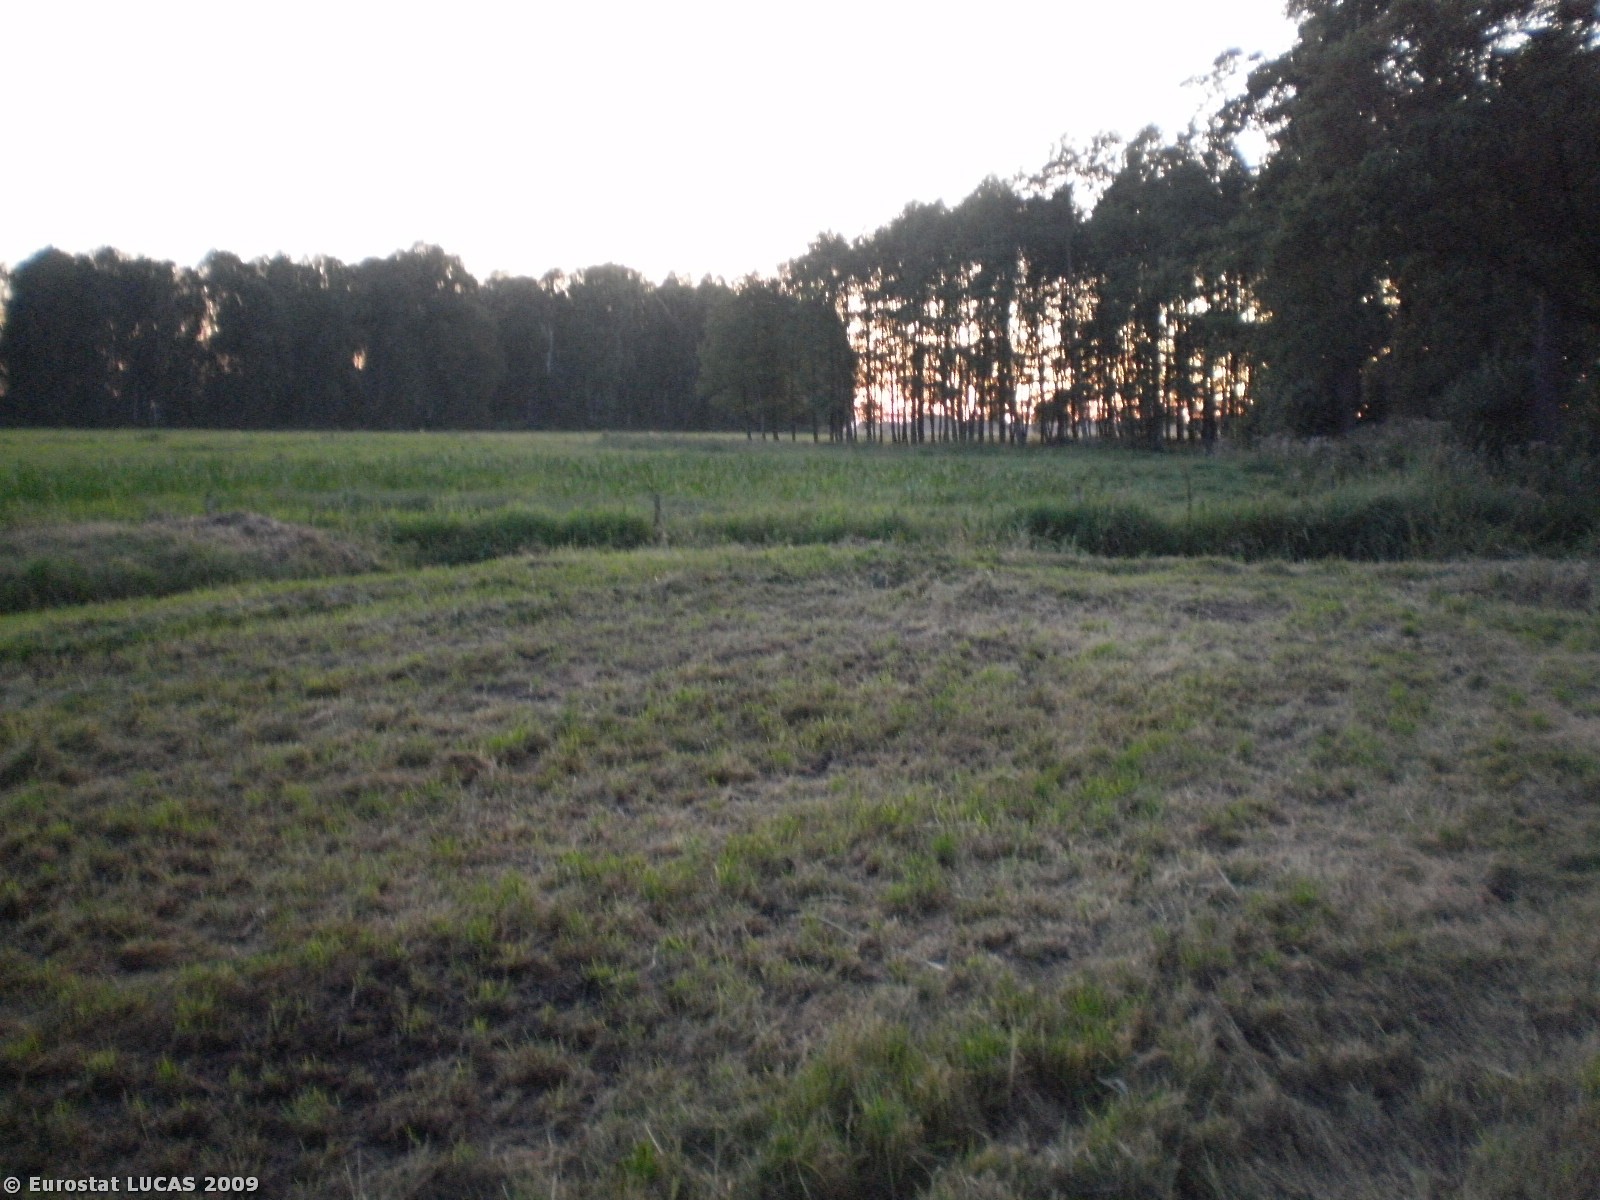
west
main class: Woodland
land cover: Broadleaved woodland
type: mire and swamp forests
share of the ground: 50 - 75 %
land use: Unused
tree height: > 5 m
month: August
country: PL
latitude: 53.3747
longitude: 21.9159
